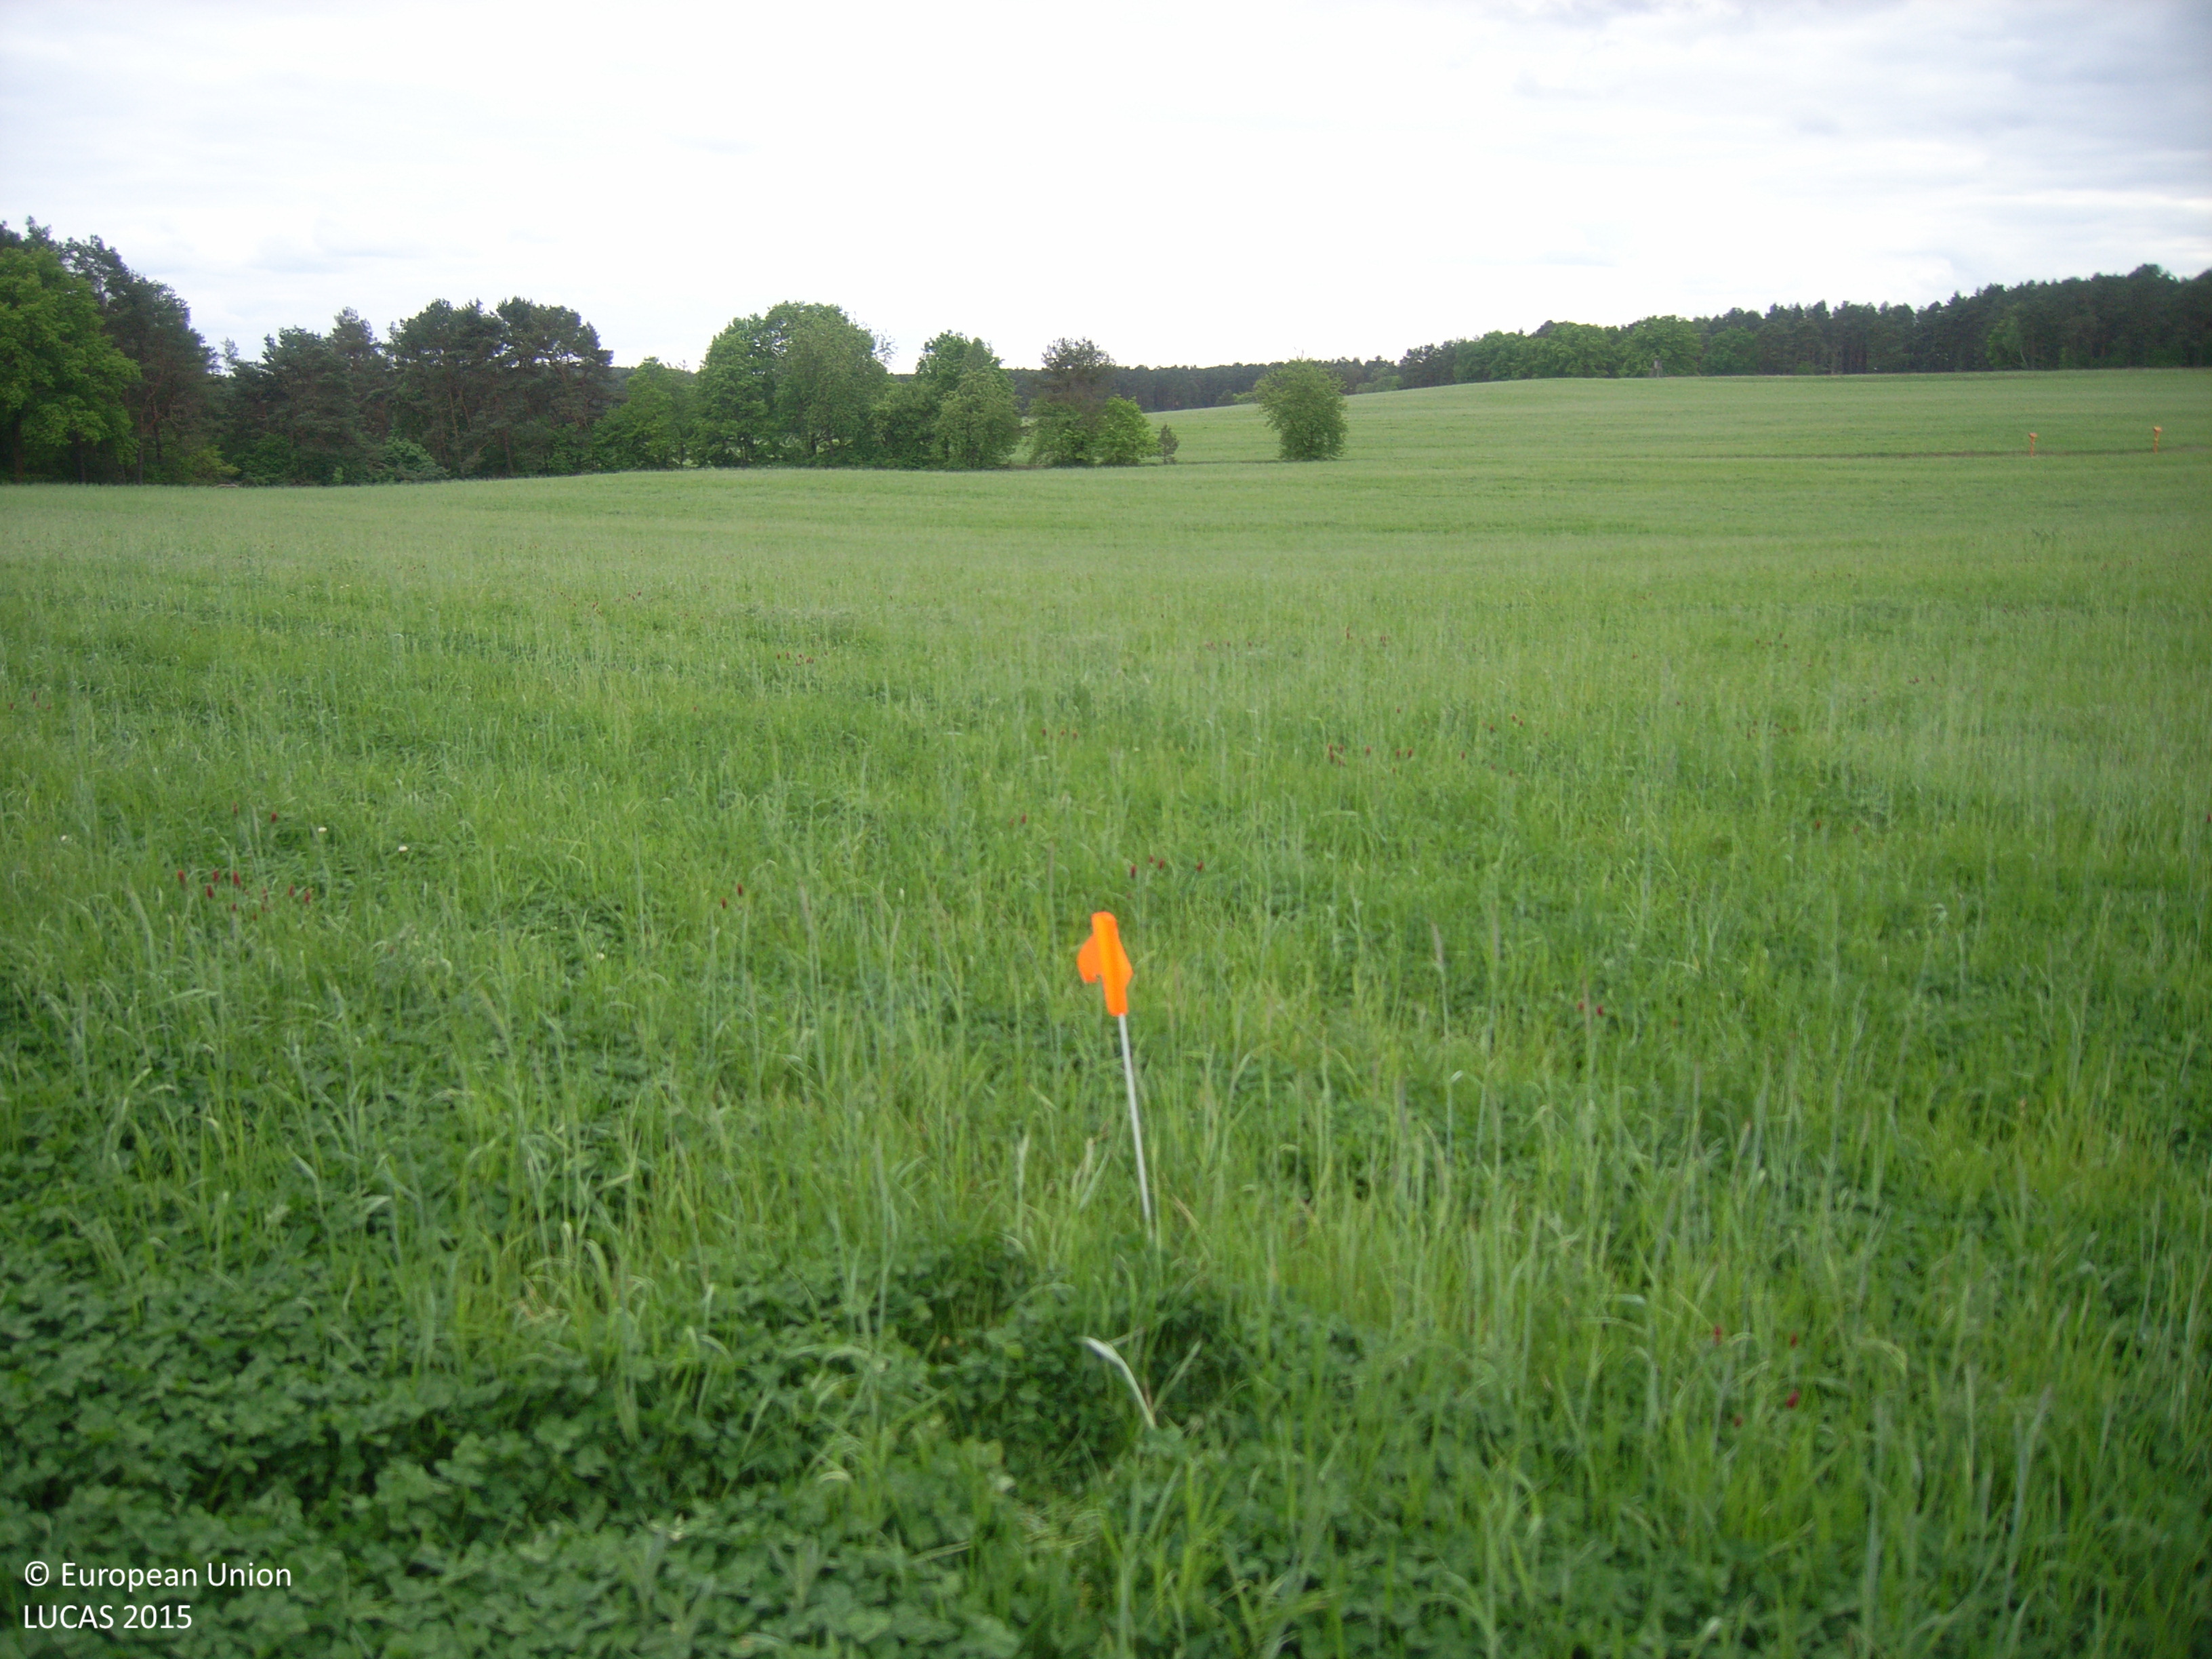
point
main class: Cropland
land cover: Other leguminous and mixtures for fodder
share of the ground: > 75 %
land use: Agriculture (excluding fallow land and kitchen gardens)
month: May
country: DE
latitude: 52.1436
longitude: 13.5805
